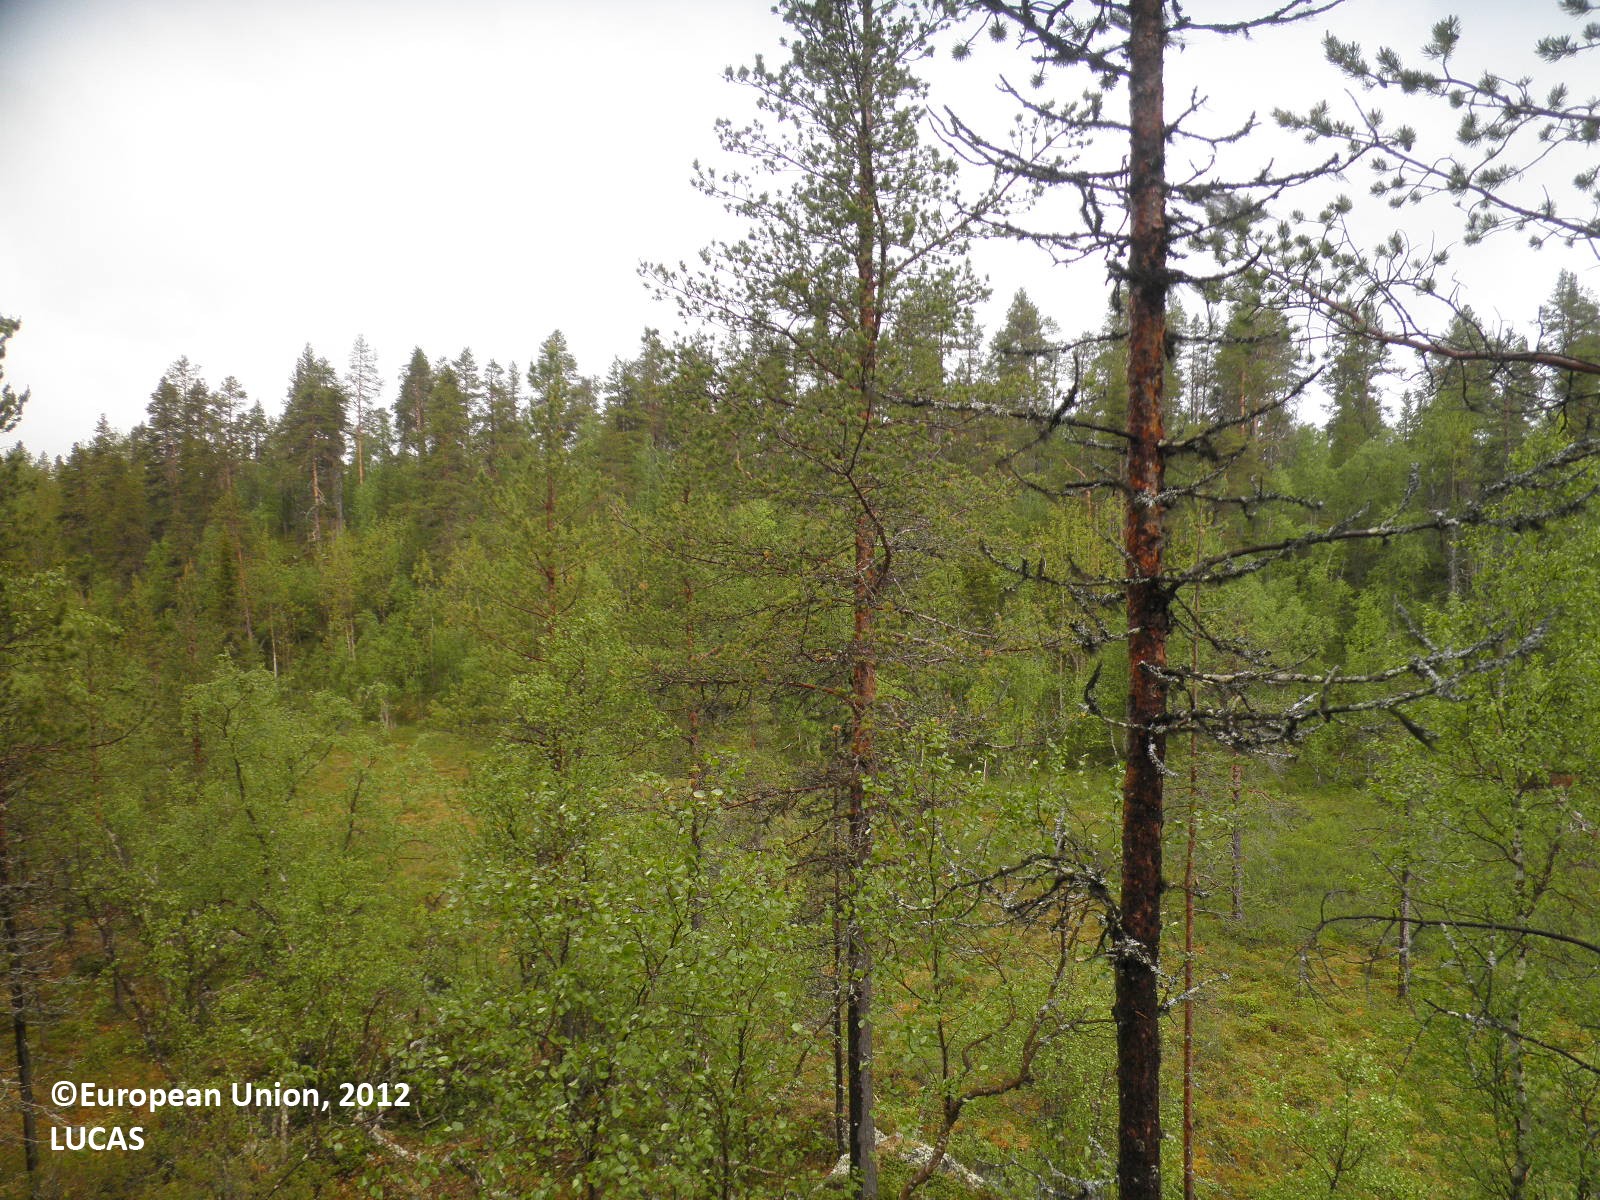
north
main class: Woodland
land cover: Pine dominated mixed woodland
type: boreal forest
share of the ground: 50 - 75 %
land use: Forestry
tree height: > 5 m
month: June
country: FI
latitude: 68.4034
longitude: 26.4391
